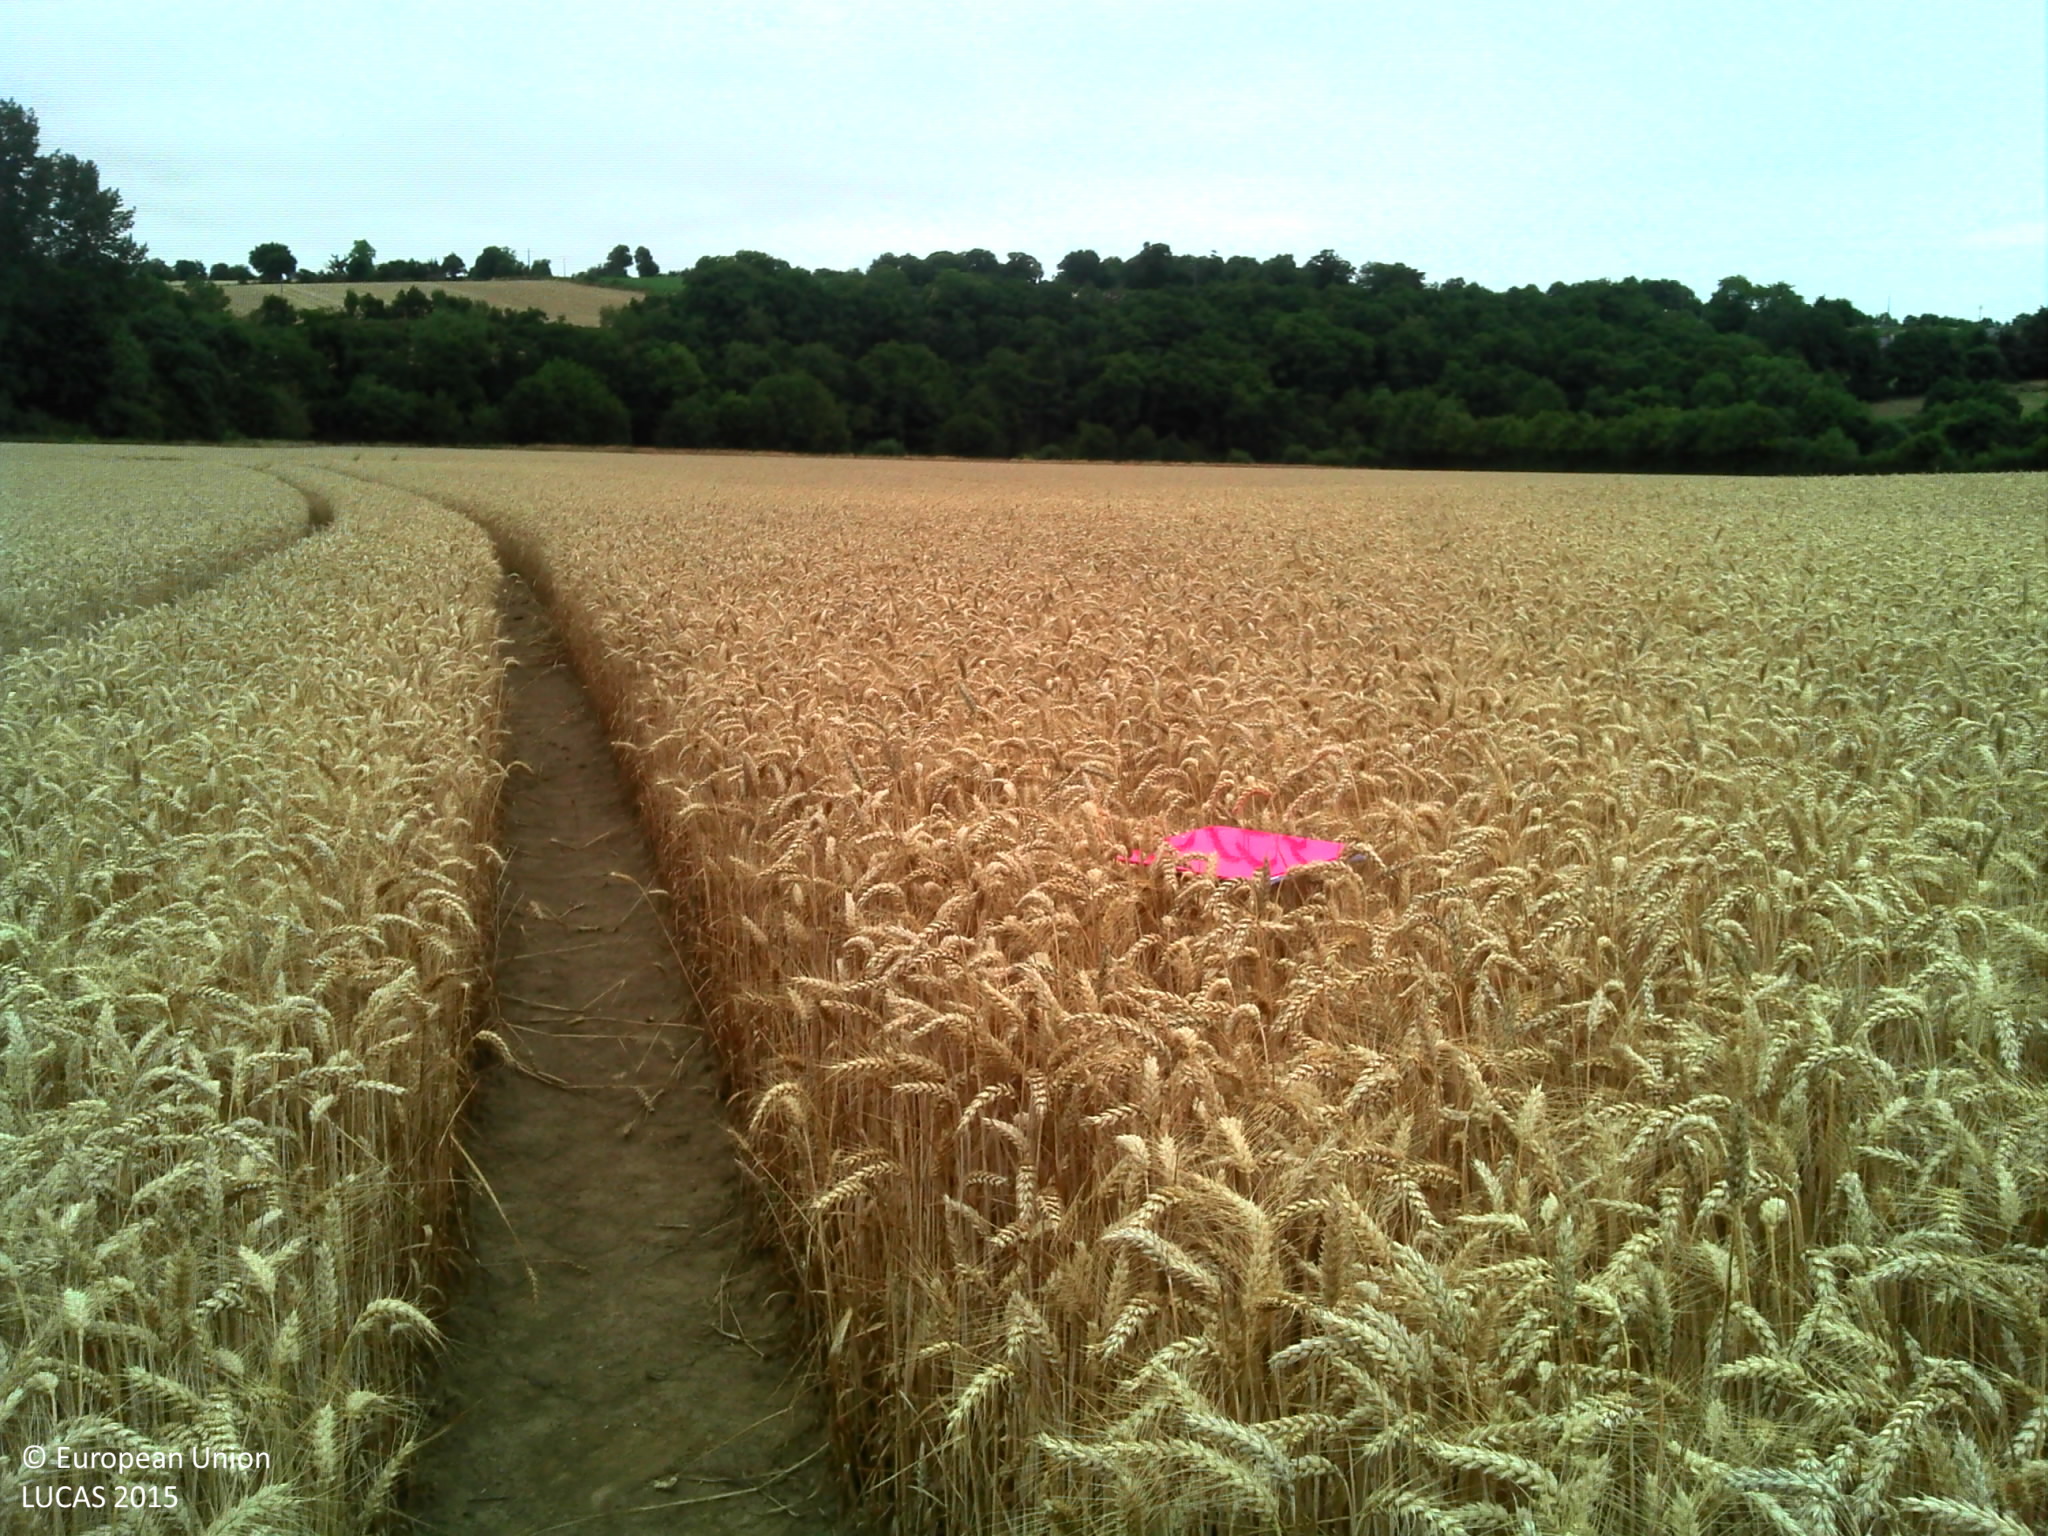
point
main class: Cropland
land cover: Common wheat
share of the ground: > 75 %
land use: Agriculture (excluding fallow land and kitchen gardens)
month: July
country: FR
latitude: 47.8475
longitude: -1.5781
